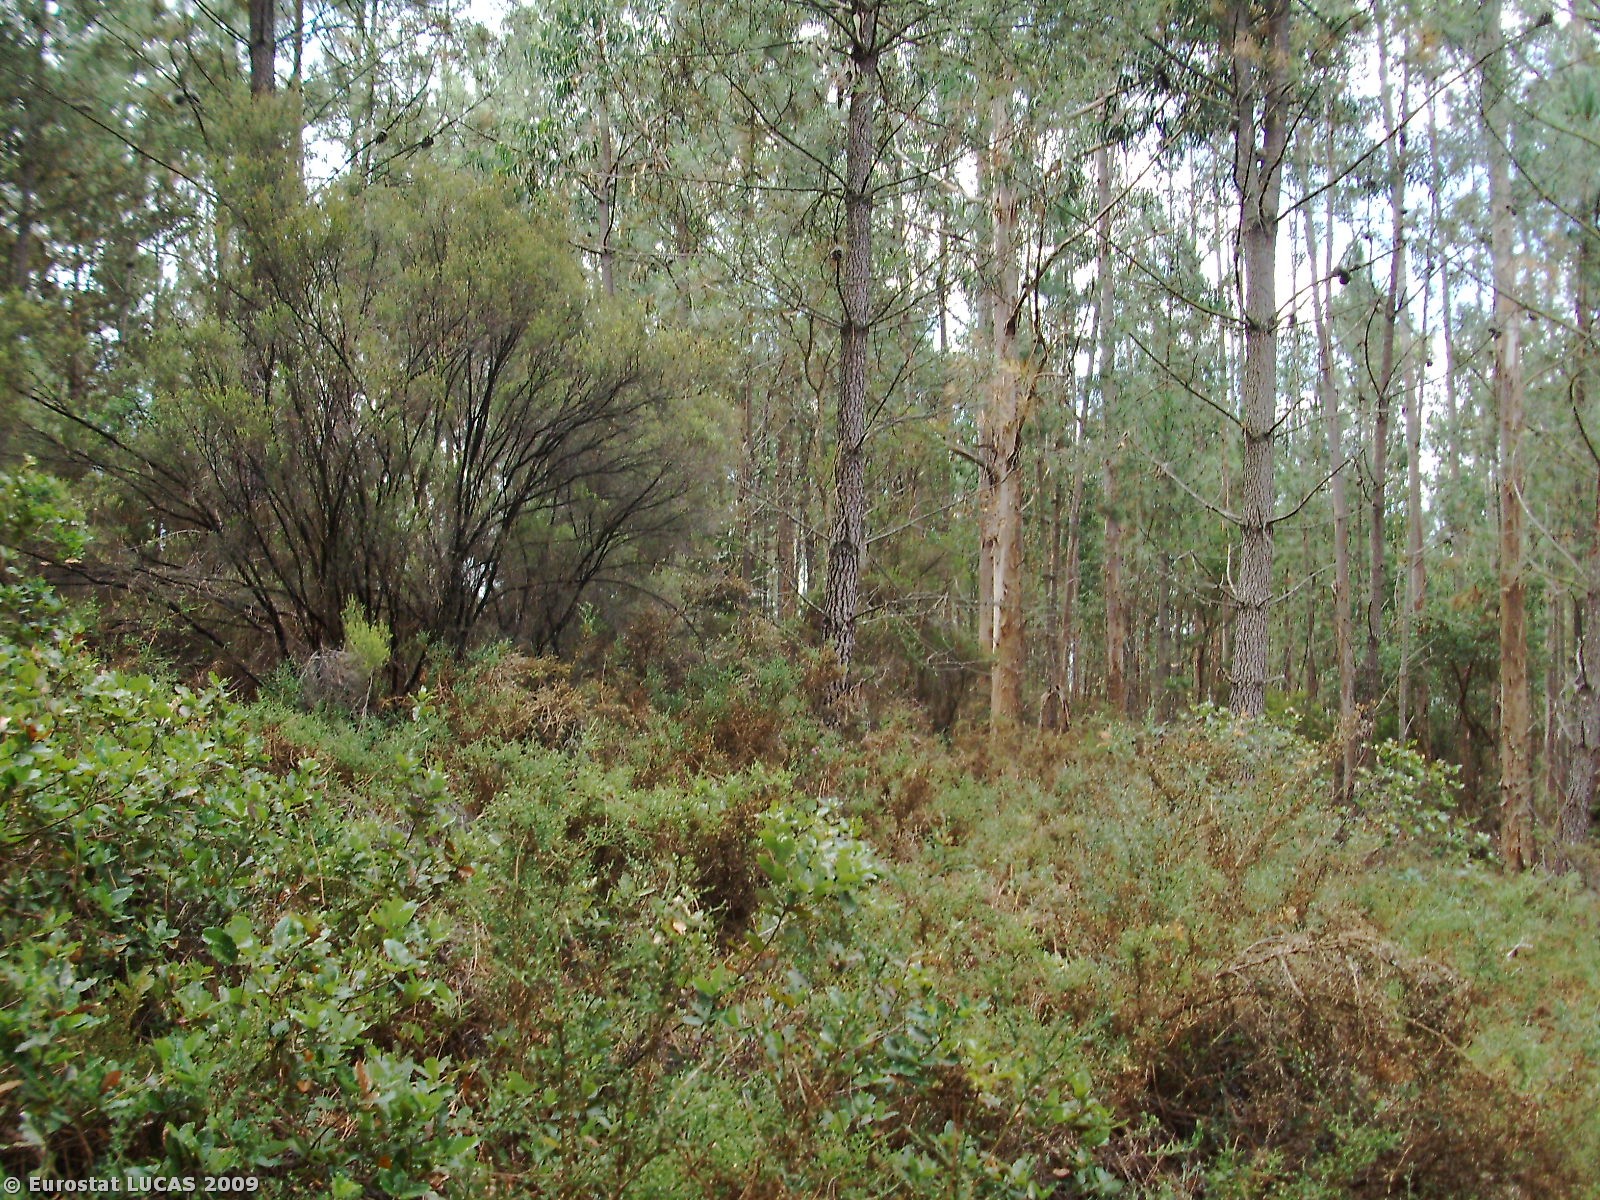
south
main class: Woodland
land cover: Coniferous woodland
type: coniferous forest of the mediterranean region
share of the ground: > 75 %
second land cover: Shrubland with sparse tree cover
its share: 10 - 25 %
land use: Forestry
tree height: > 5 m
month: August
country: PT
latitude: 40.1109
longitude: -8.3467
